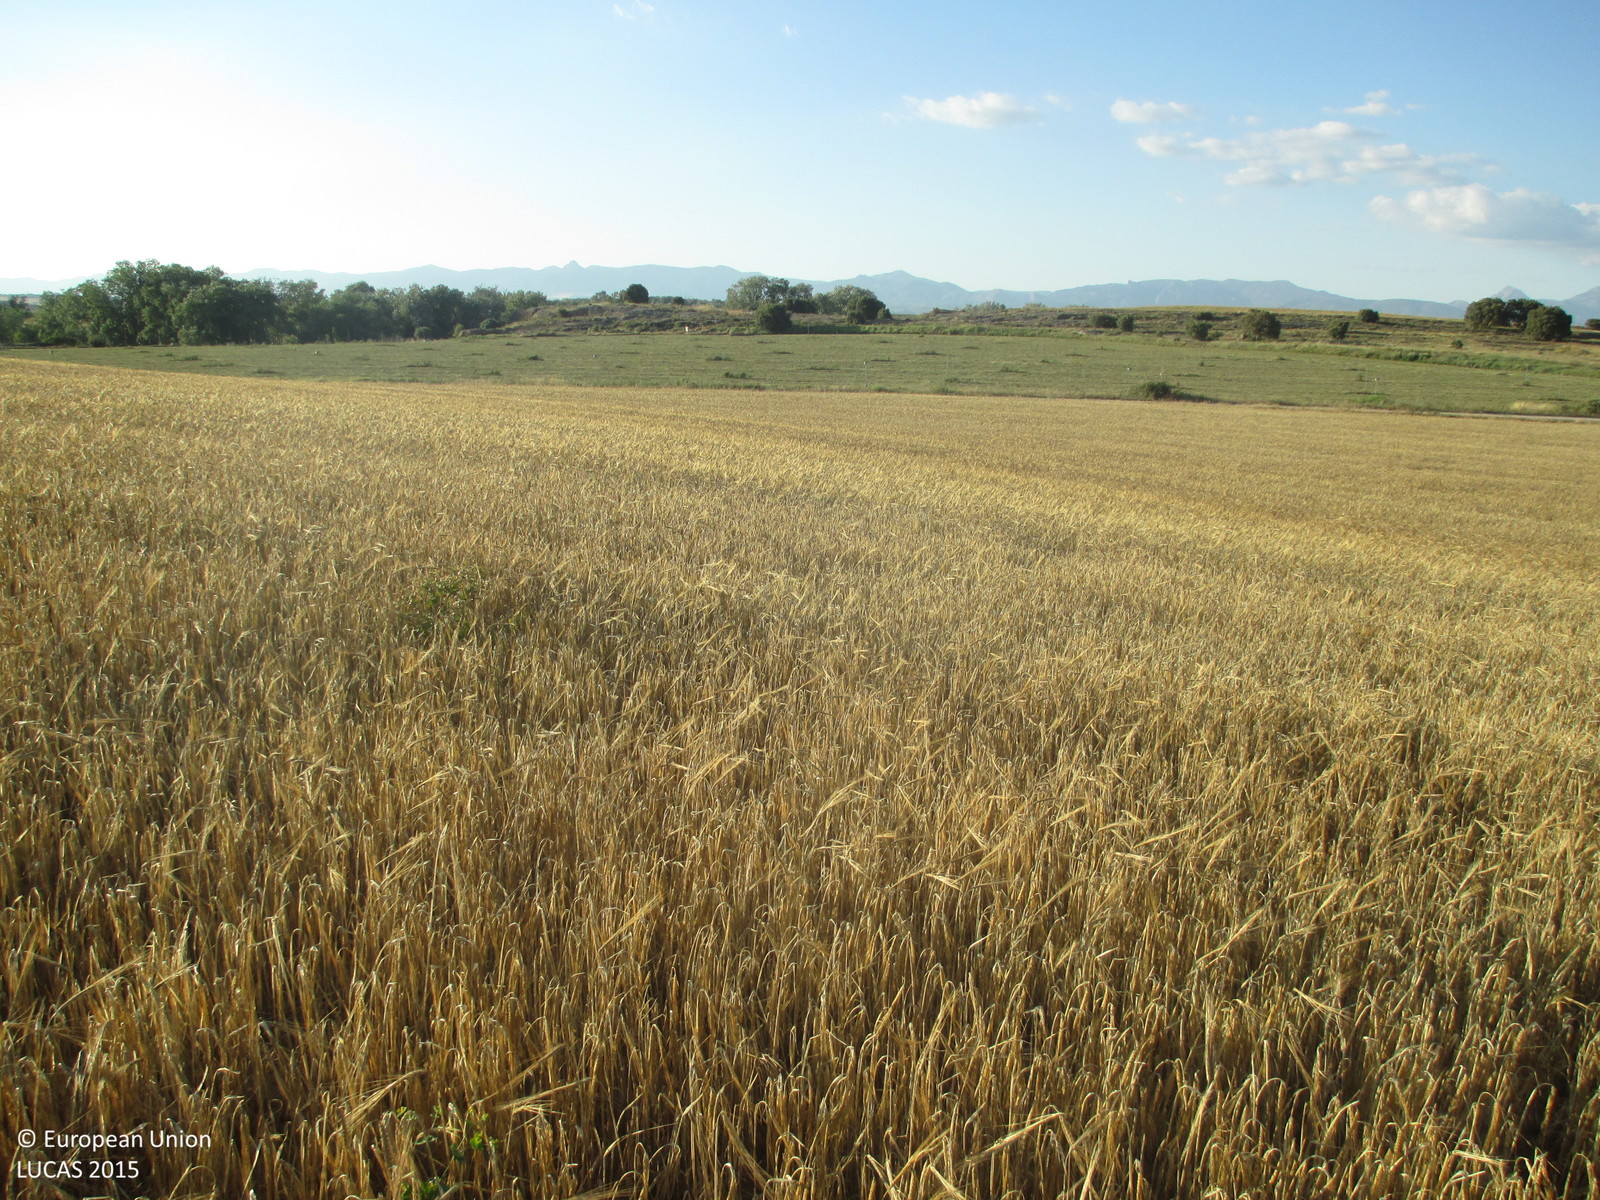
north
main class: Cropland
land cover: Barley
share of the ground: > 75 %
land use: Agriculture (excluding fallow land and kitchen gardens)
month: June
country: ES
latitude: 42.0445
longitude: -0.3995
